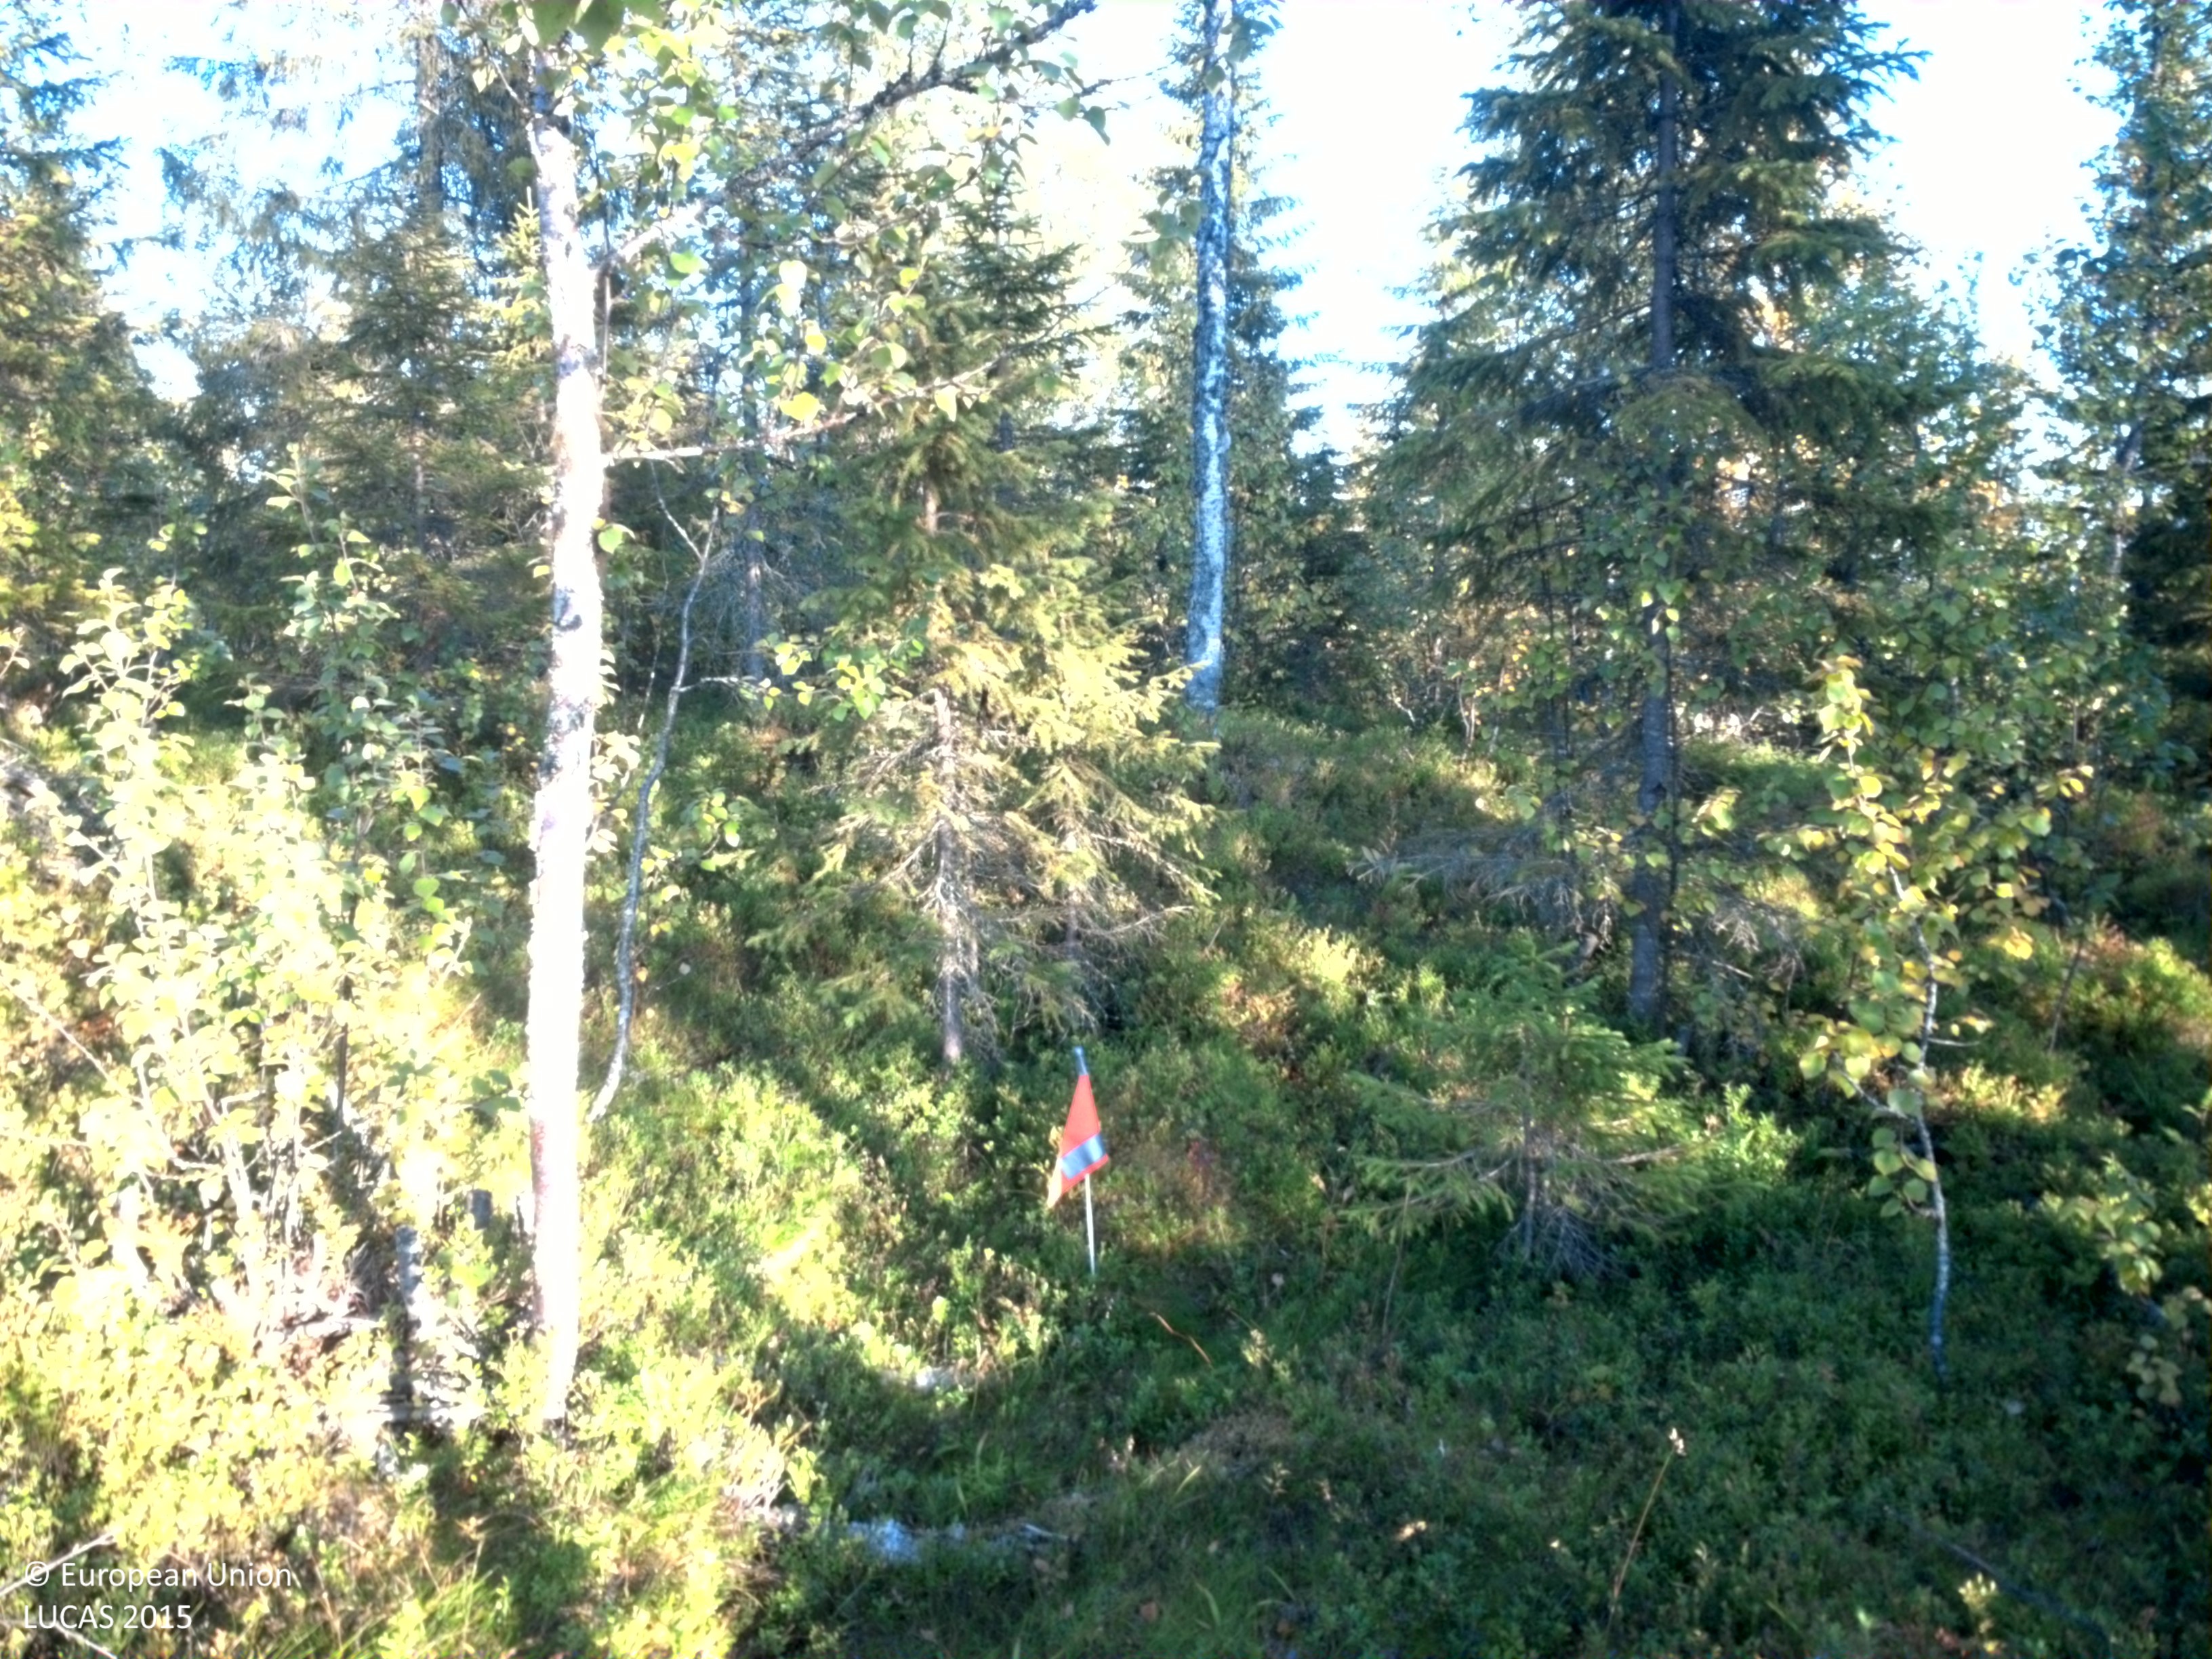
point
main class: Woodland
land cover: Spruce dominated mixed woodland
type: boreal forest
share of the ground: 25 - 50 %
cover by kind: shrubs 45 %, coniferous forest trees 15 %, broadleaved forest trees 15 %, herbaceous plants 15 %, lichens and mosses 10 %
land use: Forestry
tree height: > 5 m
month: September
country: SE
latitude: 65.3043
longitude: 16.8050
